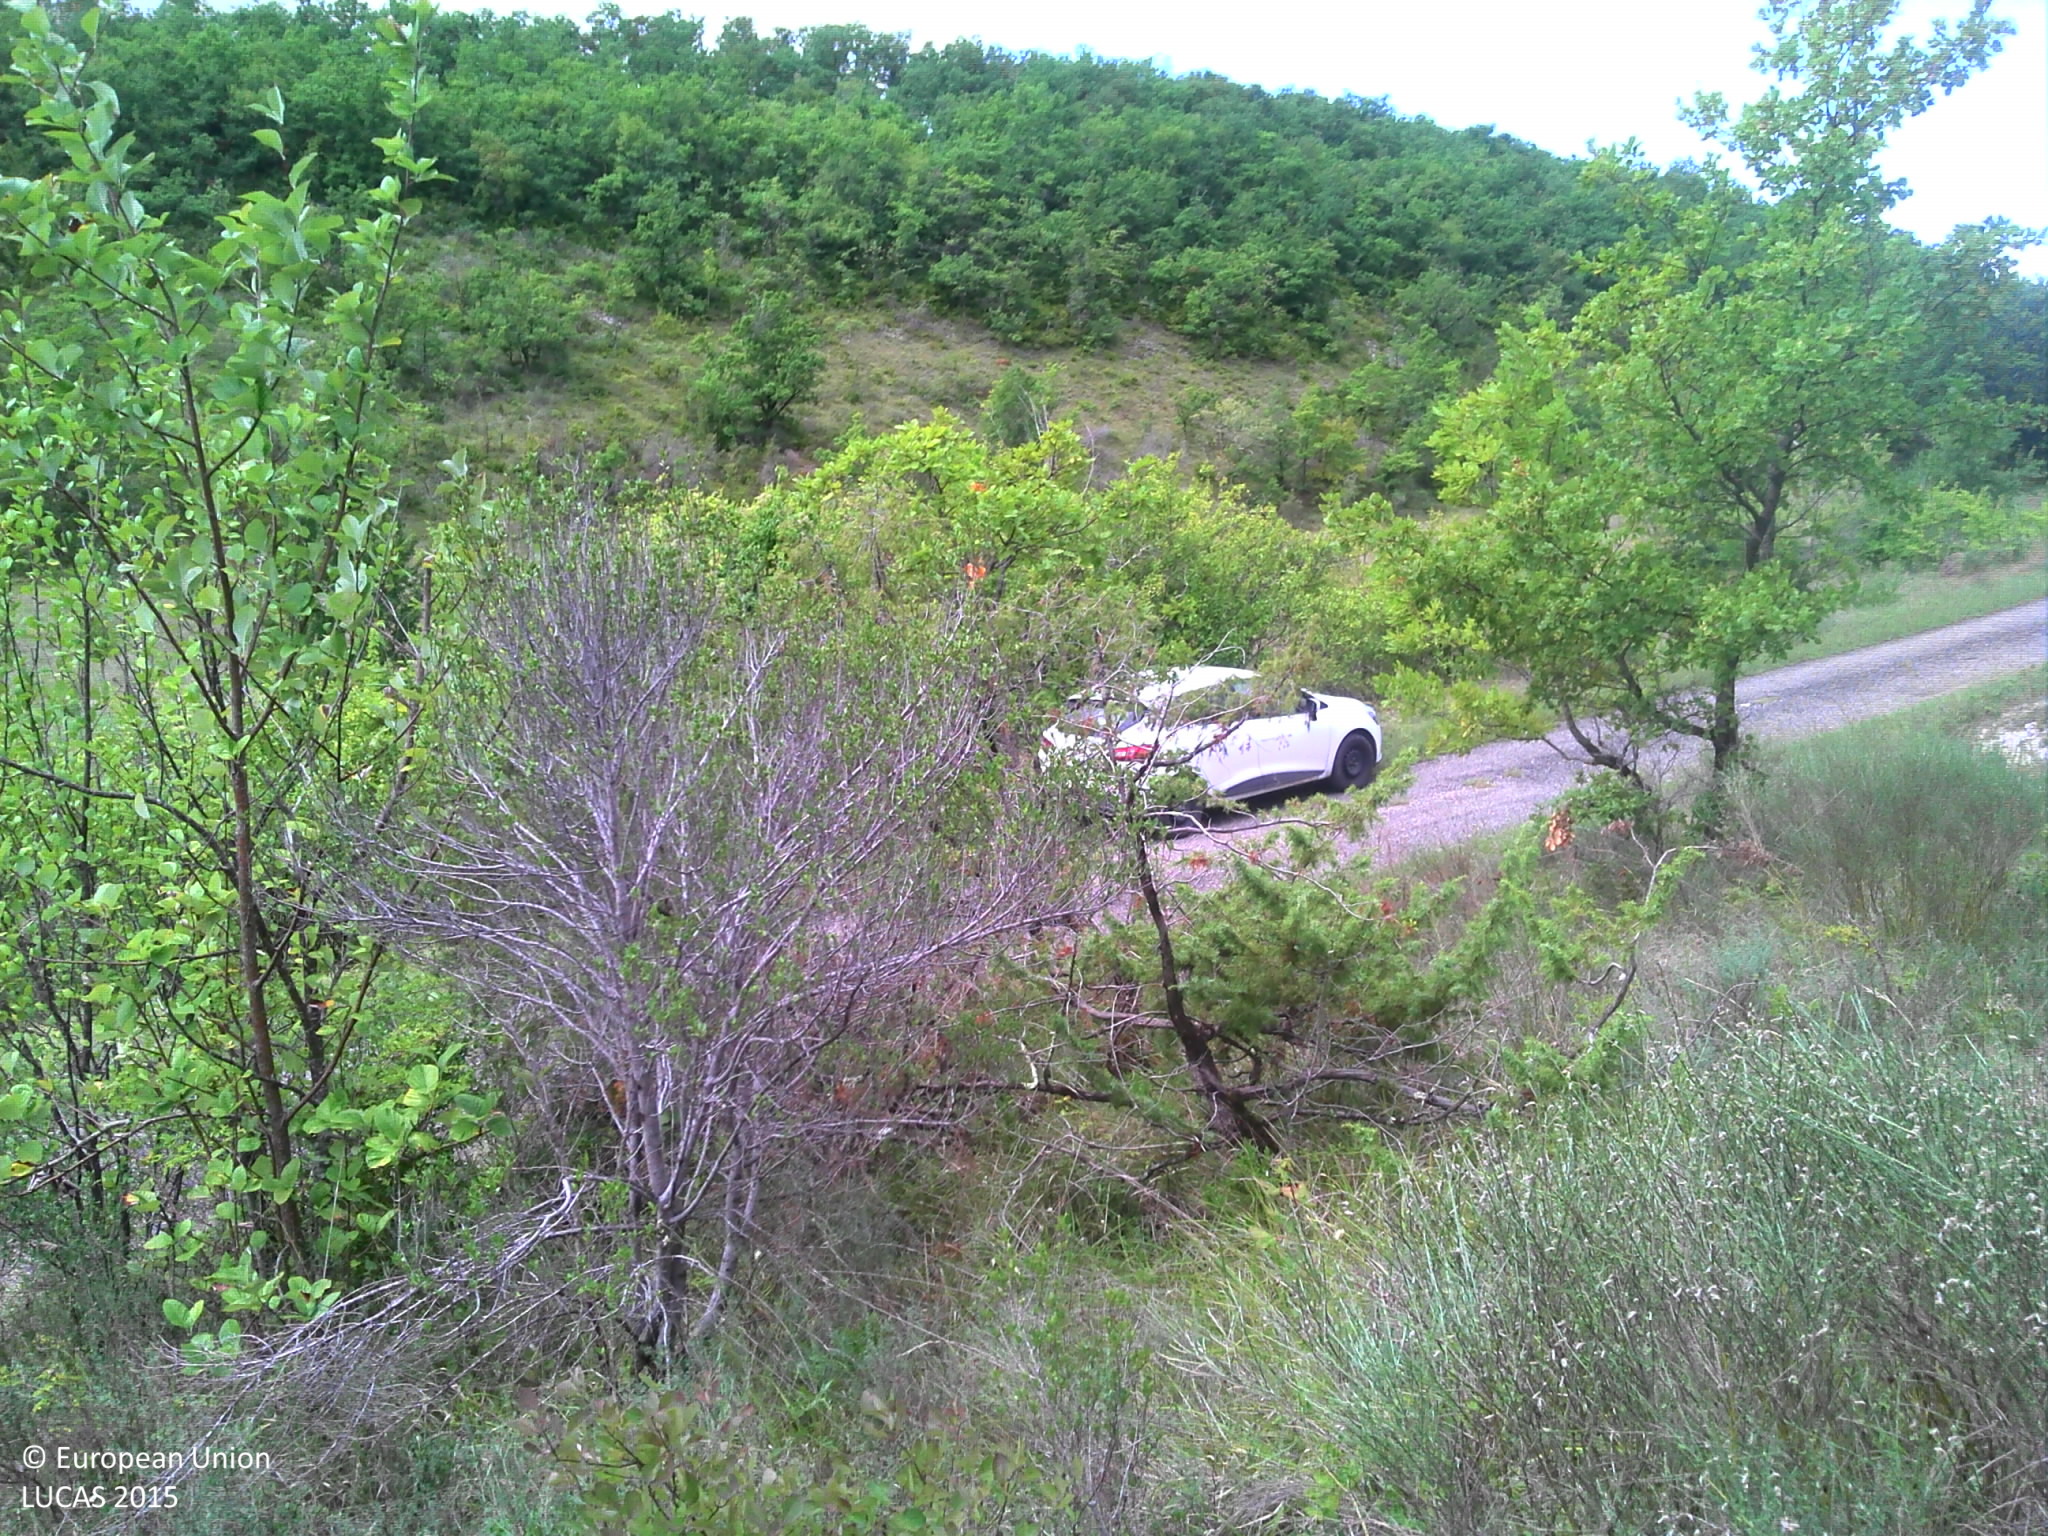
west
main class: Shrubland
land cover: Shrubland with sparse tree cover
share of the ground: > 75 %
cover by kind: shrubs 65 %, herbaceous plants 30 %, broadleaved forest trees 5 %
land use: Semi-natural and natural areas not in use
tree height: > 5 m
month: August
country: FR
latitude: 44.3476
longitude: 1.3047
